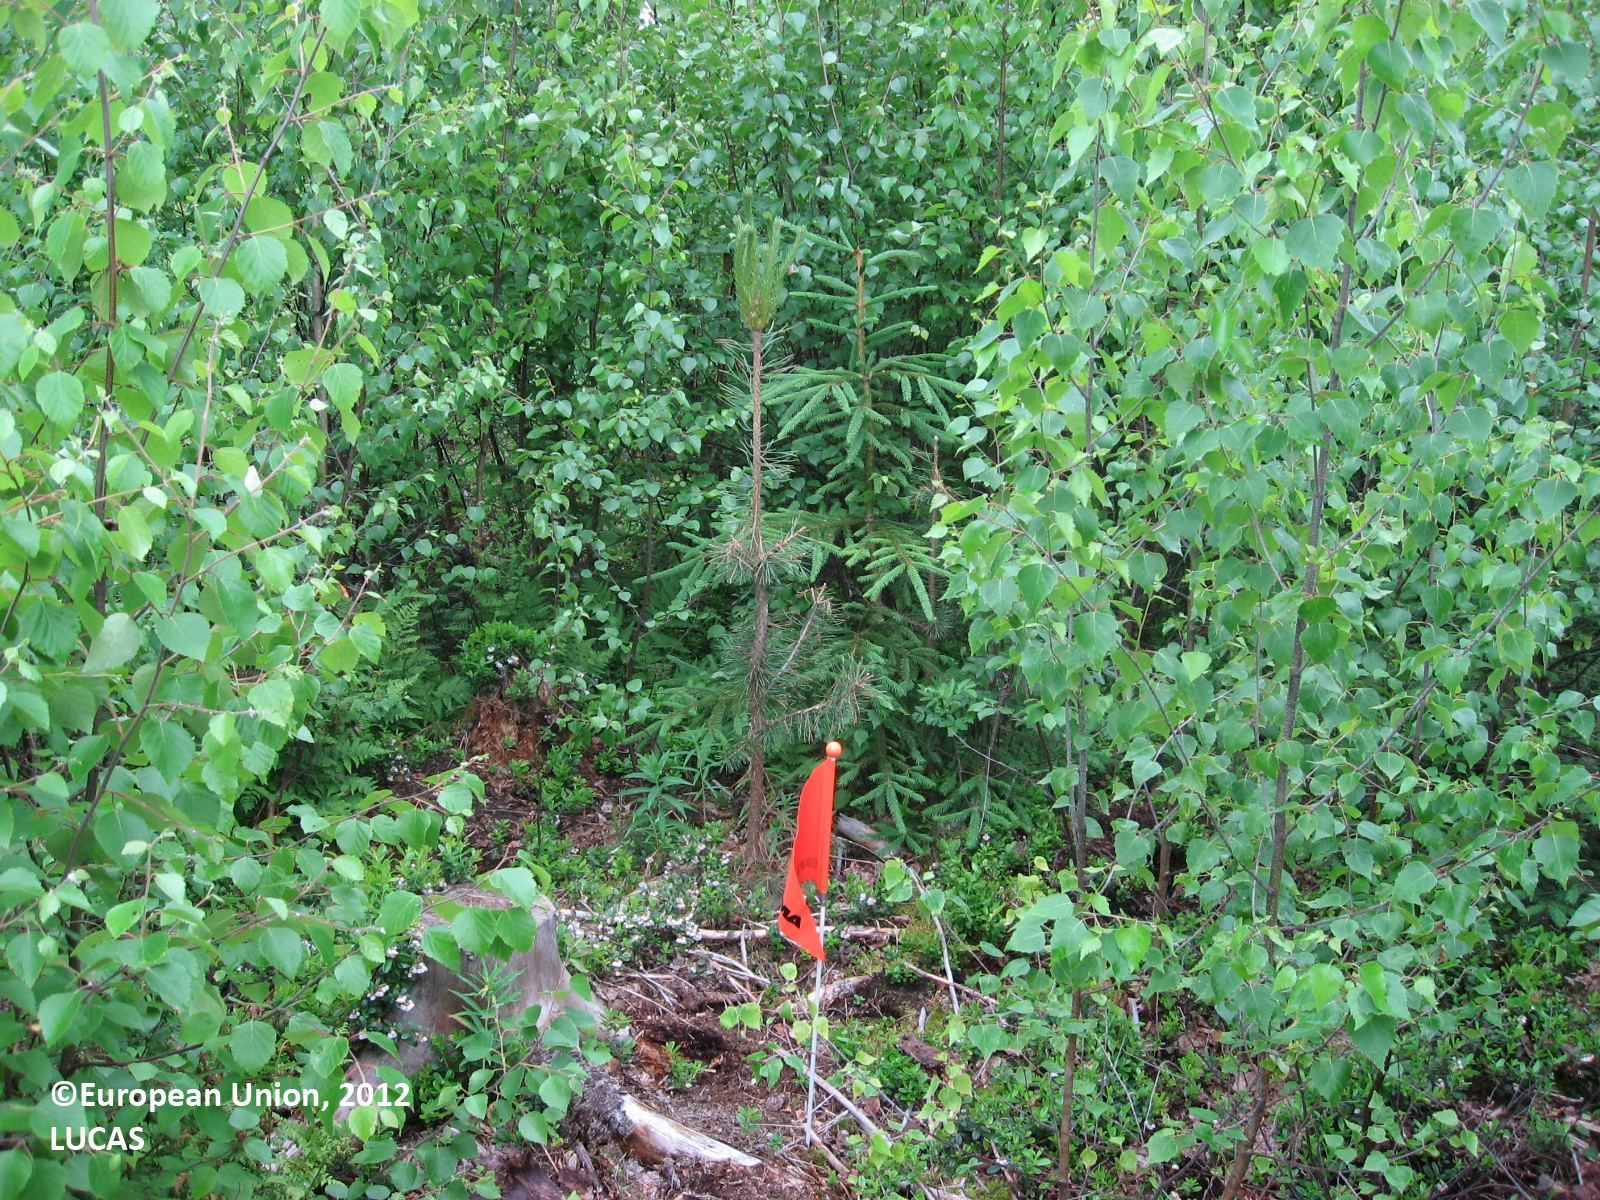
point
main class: Woodland
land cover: Broadleaved woodland
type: boreal forest
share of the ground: > 75 %
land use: Forestry
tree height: > 5 m
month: June
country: FI
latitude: 60.4568
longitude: 26.3144
